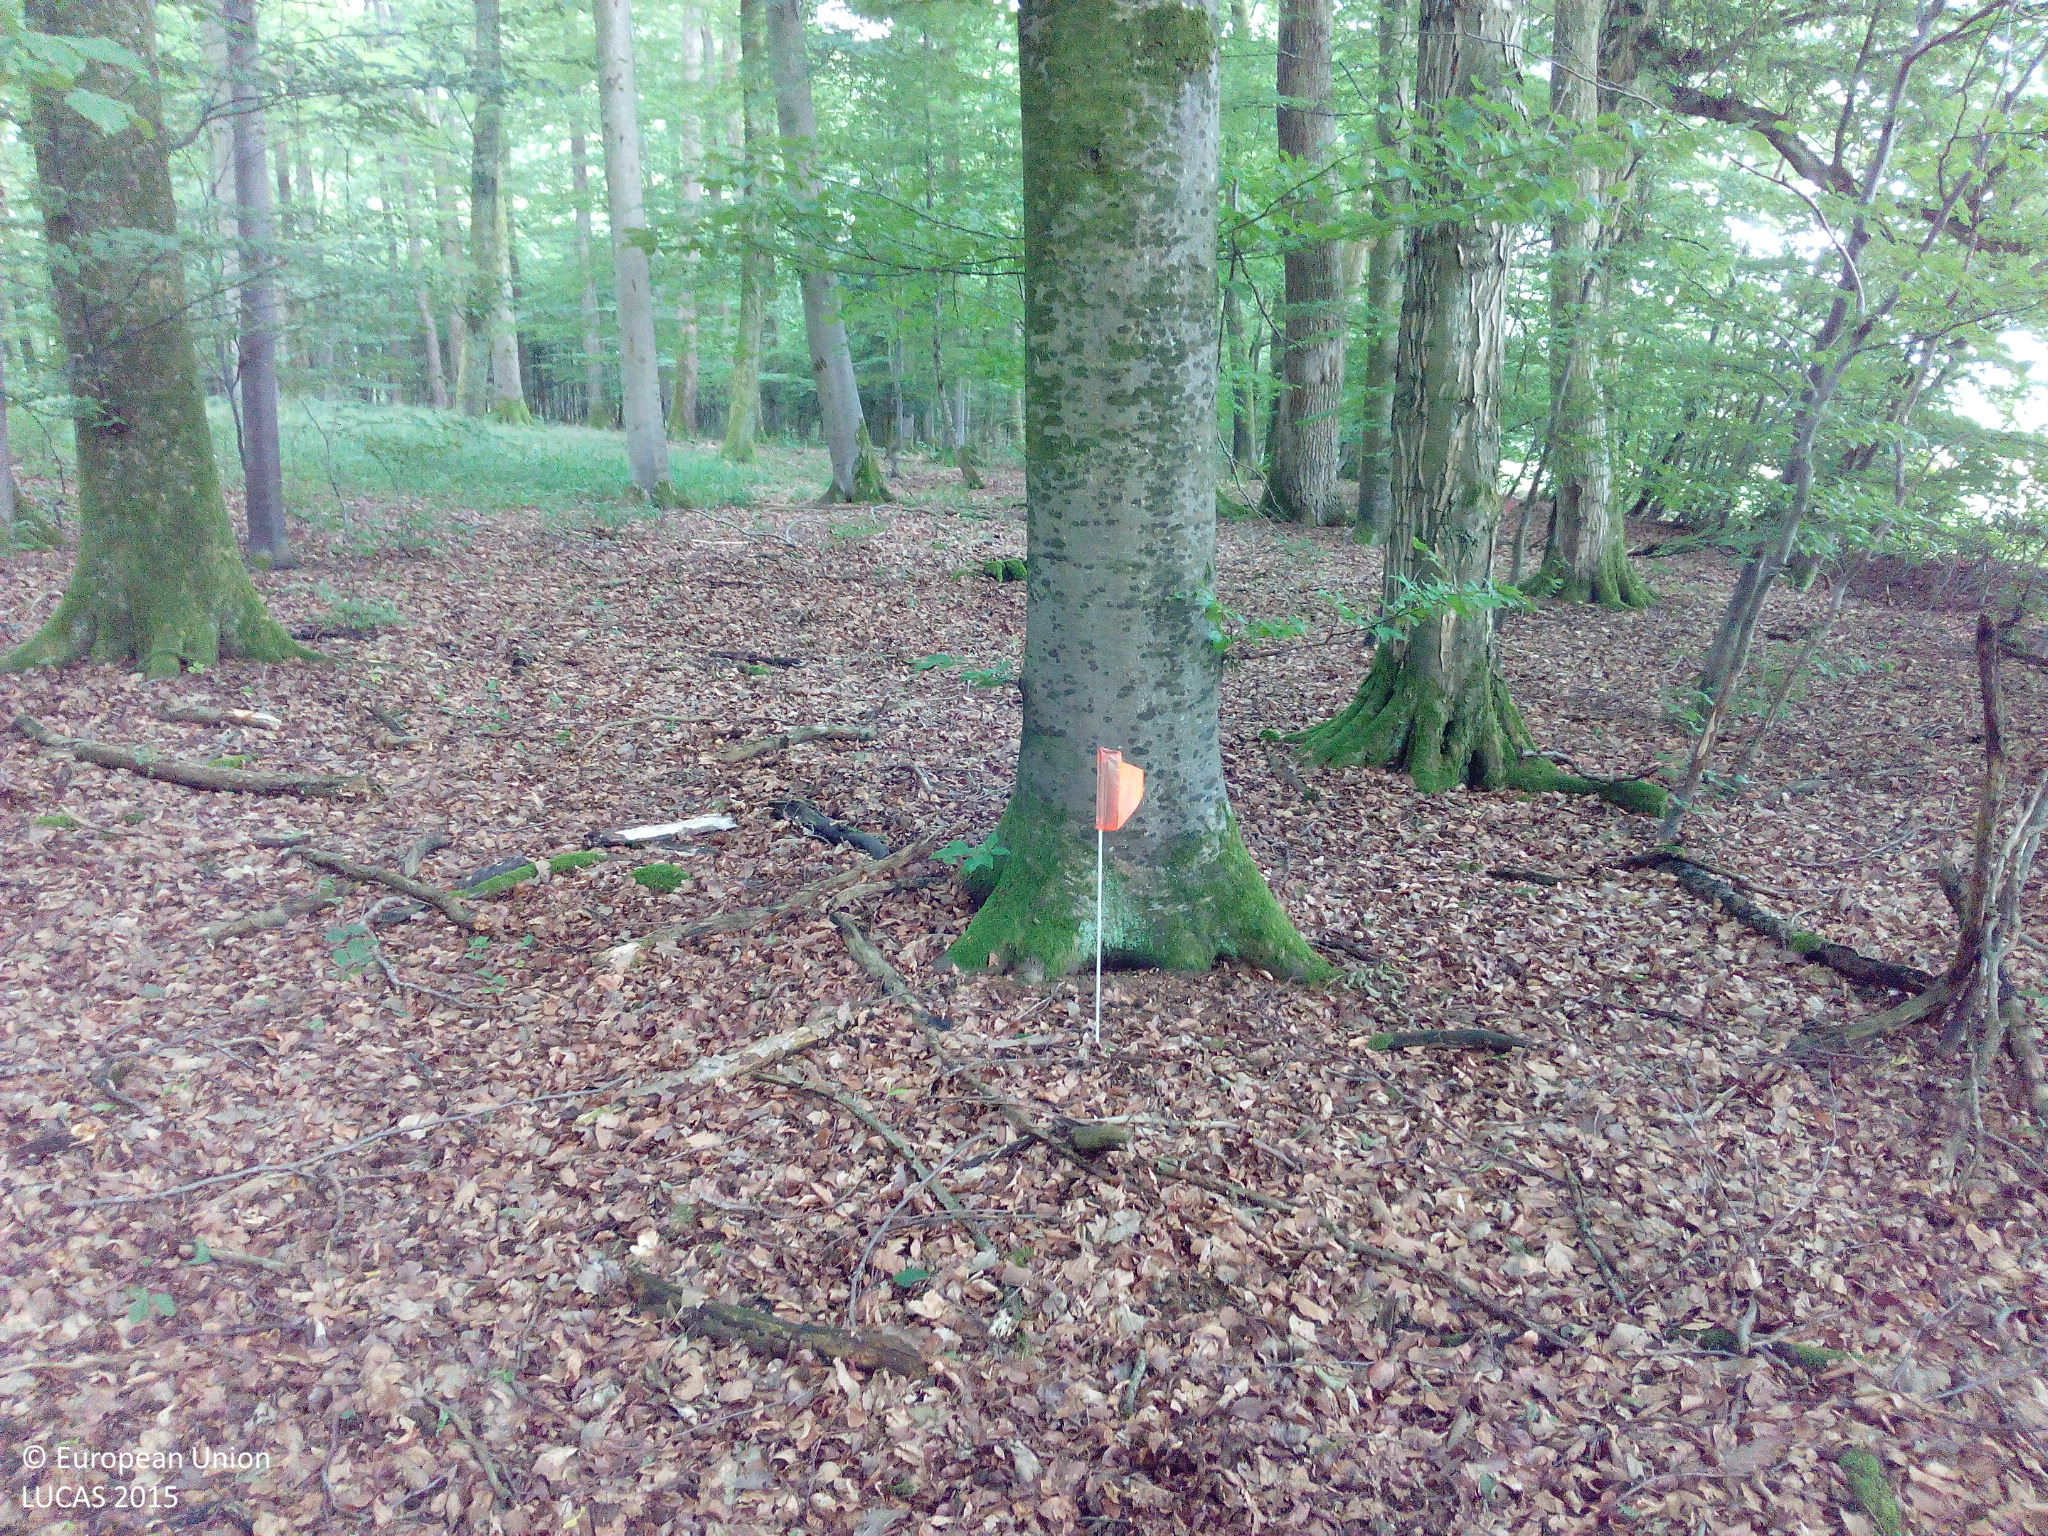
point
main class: Woodland
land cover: Broadleaved woodland
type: mesophytic deciduous forest
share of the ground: > 75 %
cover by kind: broadleaved forest trees 100 %
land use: Forestry
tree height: > 5 m
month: June
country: DE
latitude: 48.7269
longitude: 9.6875
